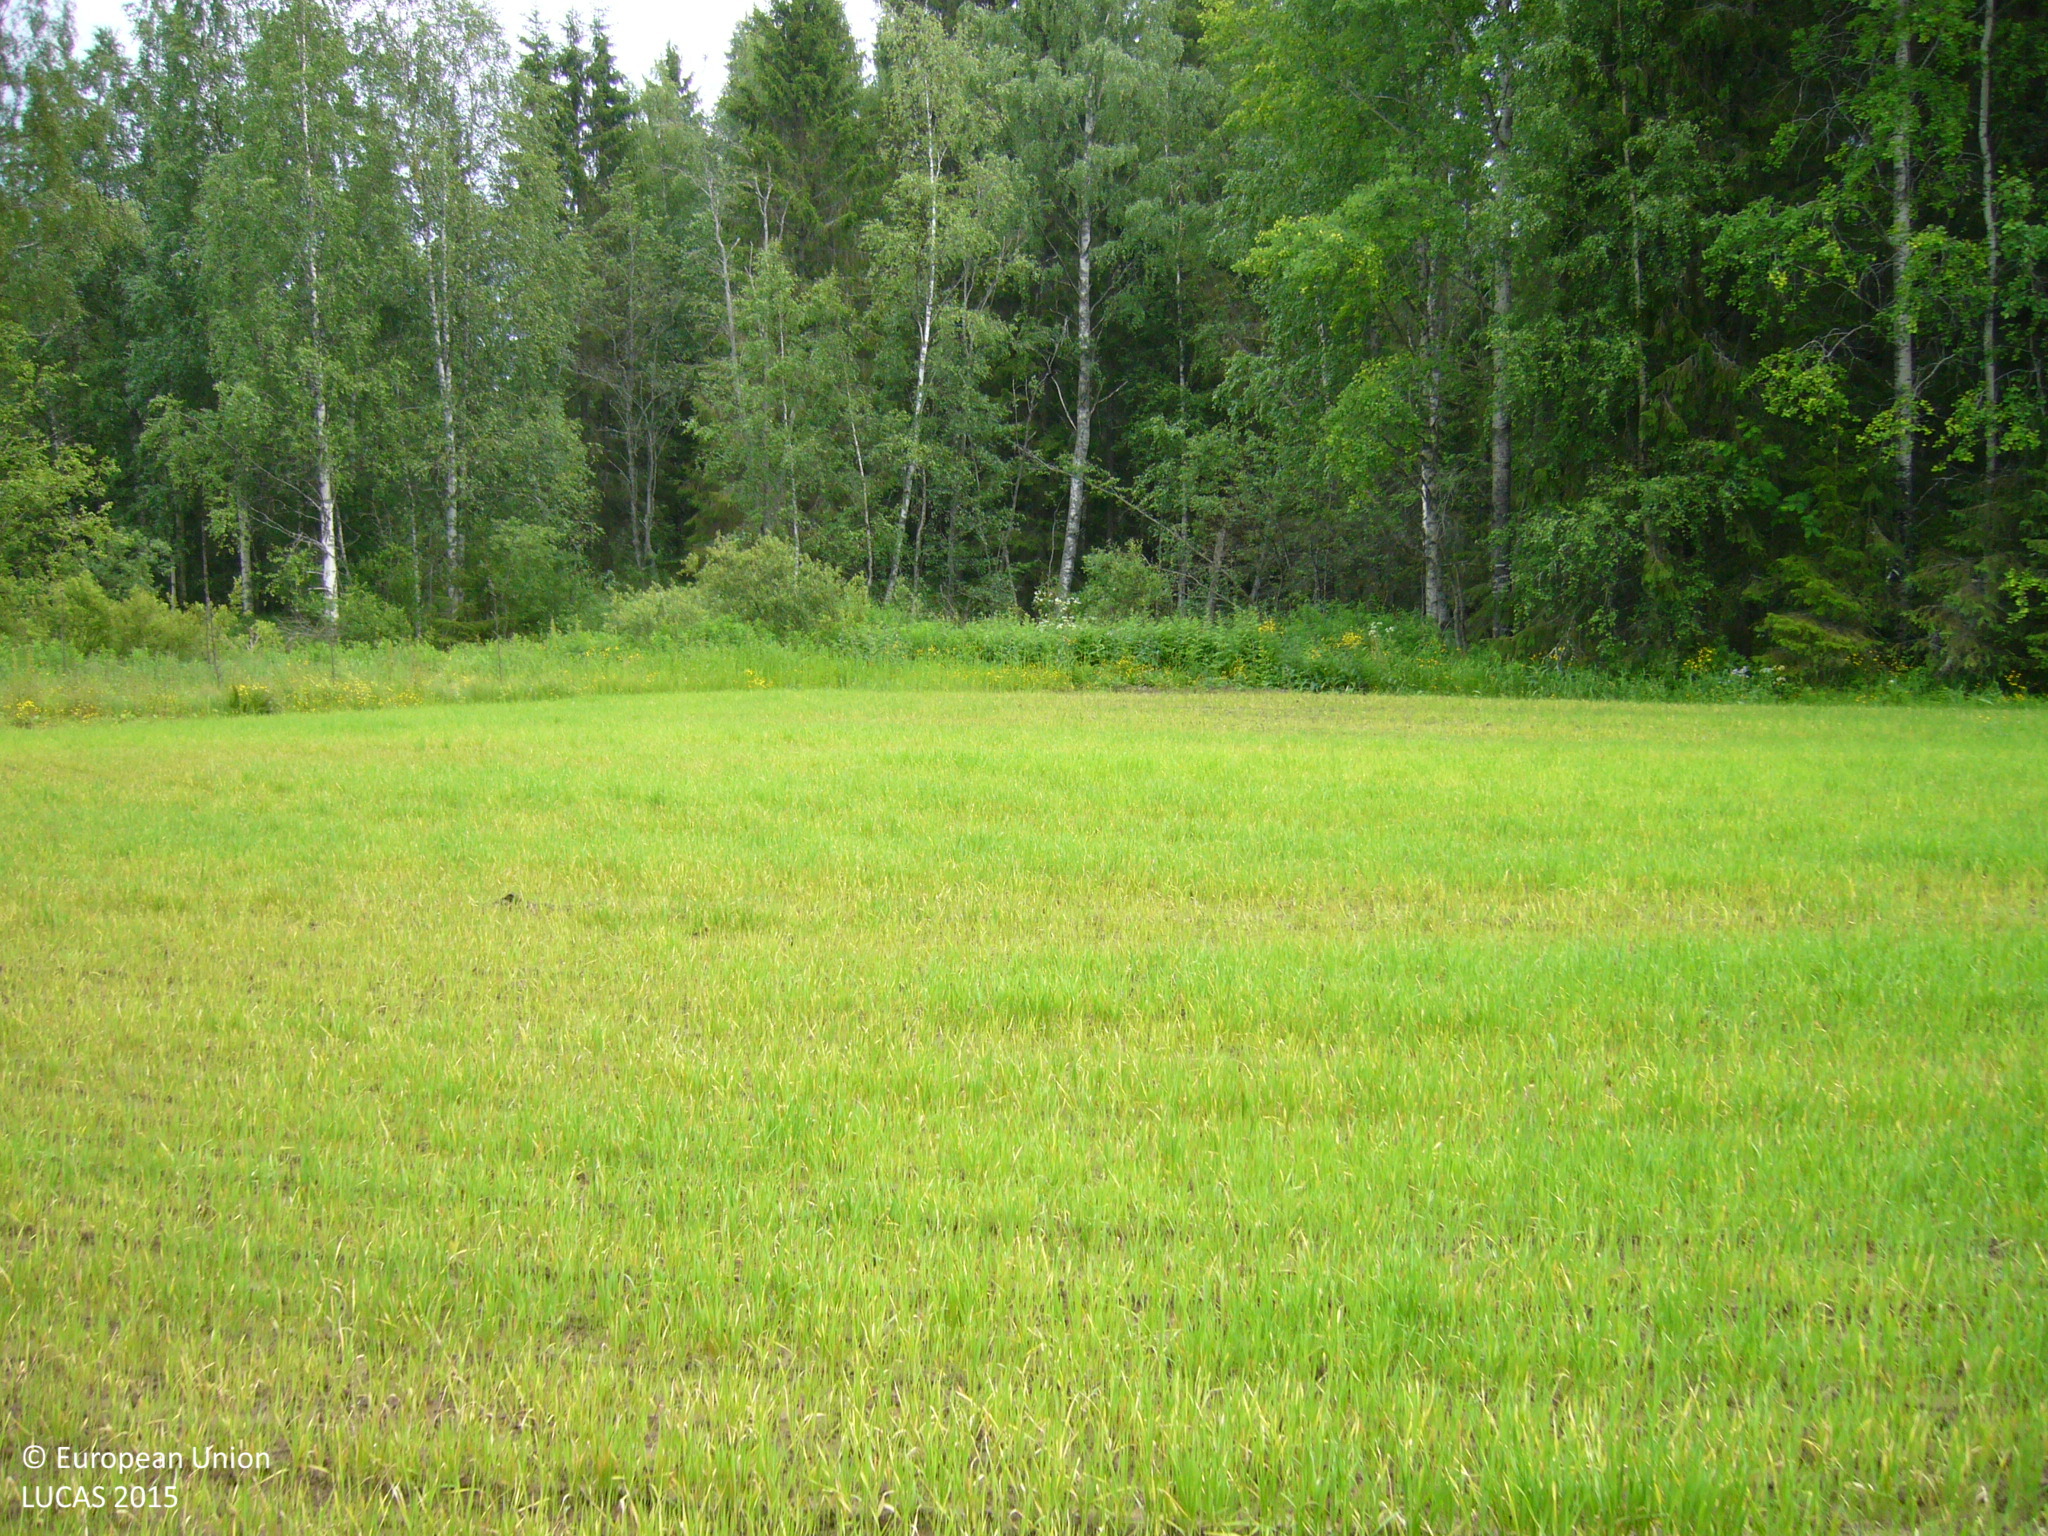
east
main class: Cropland
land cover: Barley
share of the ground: > 75 %
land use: Agriculture (excluding fallow land and kitchen gardens)
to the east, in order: Barley; Grassland without tree/shrub cover; Inland fresh running water; Other mixed woodland; Ditches and canals; Other mixed woodland
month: July
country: FI
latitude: 63.4452
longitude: 25.3153
